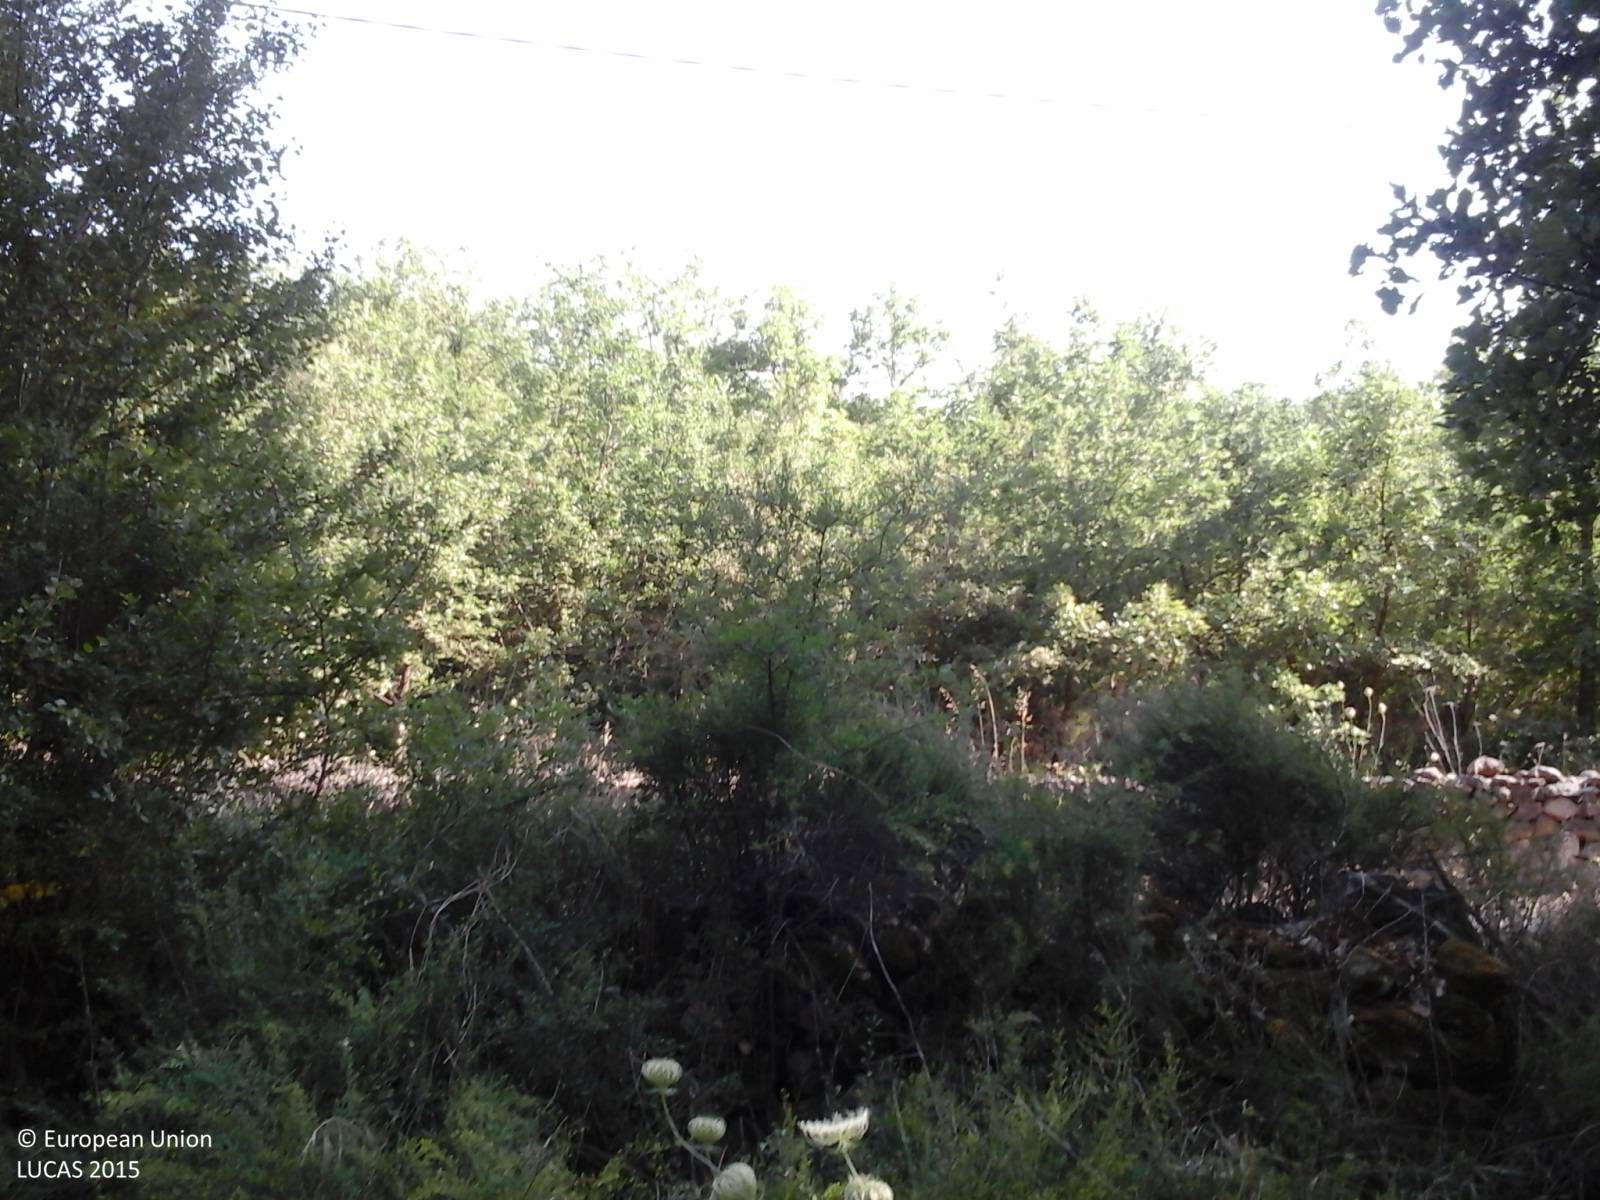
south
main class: Woodland
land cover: Broadleaved woodland
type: broadleaved evergreen forest
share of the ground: 25 - 50 %
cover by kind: broadleaved forest trees 50 %, herbaceous plants 50 %
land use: Agriculture (excluding fallow land and kitchen gardens)
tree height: < 5 m
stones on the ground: < 10 %
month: July
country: IT
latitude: 40.0254
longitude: 8.8696
